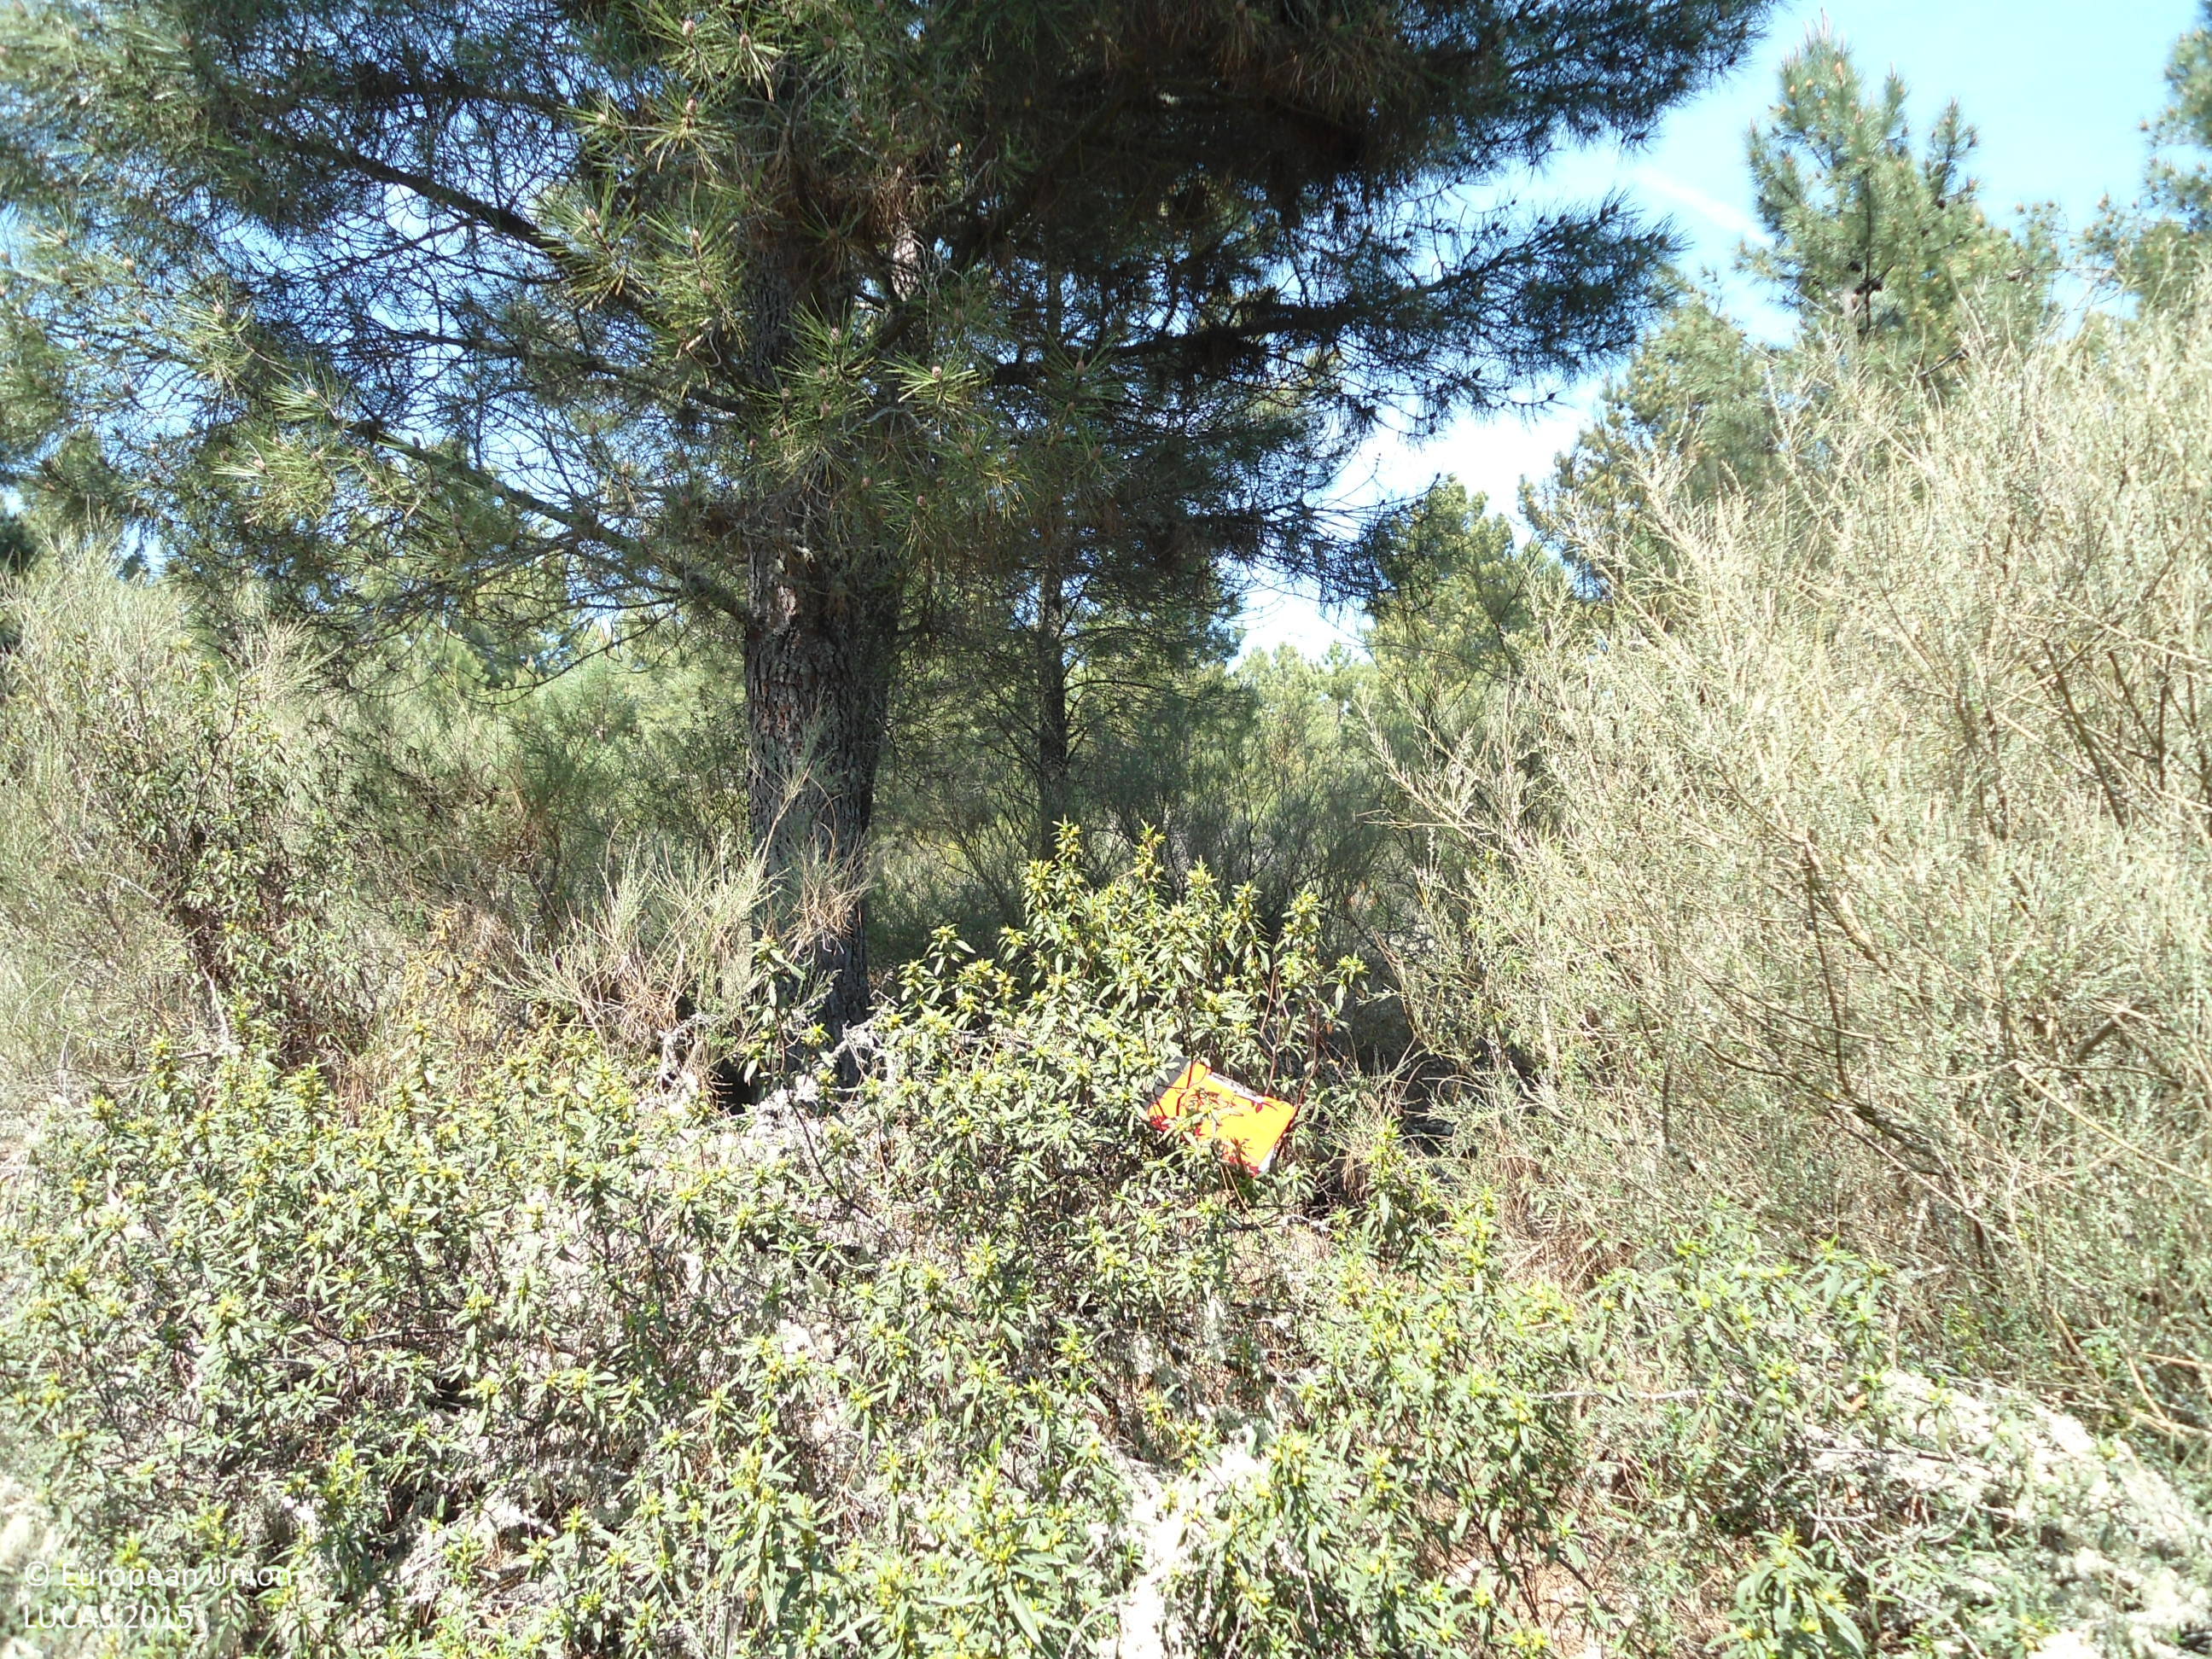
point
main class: Woodland
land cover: Pine dominated coniferous woodland
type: coniferous forest of the mediterranean region
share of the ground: > 75 %
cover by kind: coniferous forest trees 85 %, shrubs 15 %
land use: Forestry
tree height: < 5 m
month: April
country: ES
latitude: 41.8596
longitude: -6.2811
